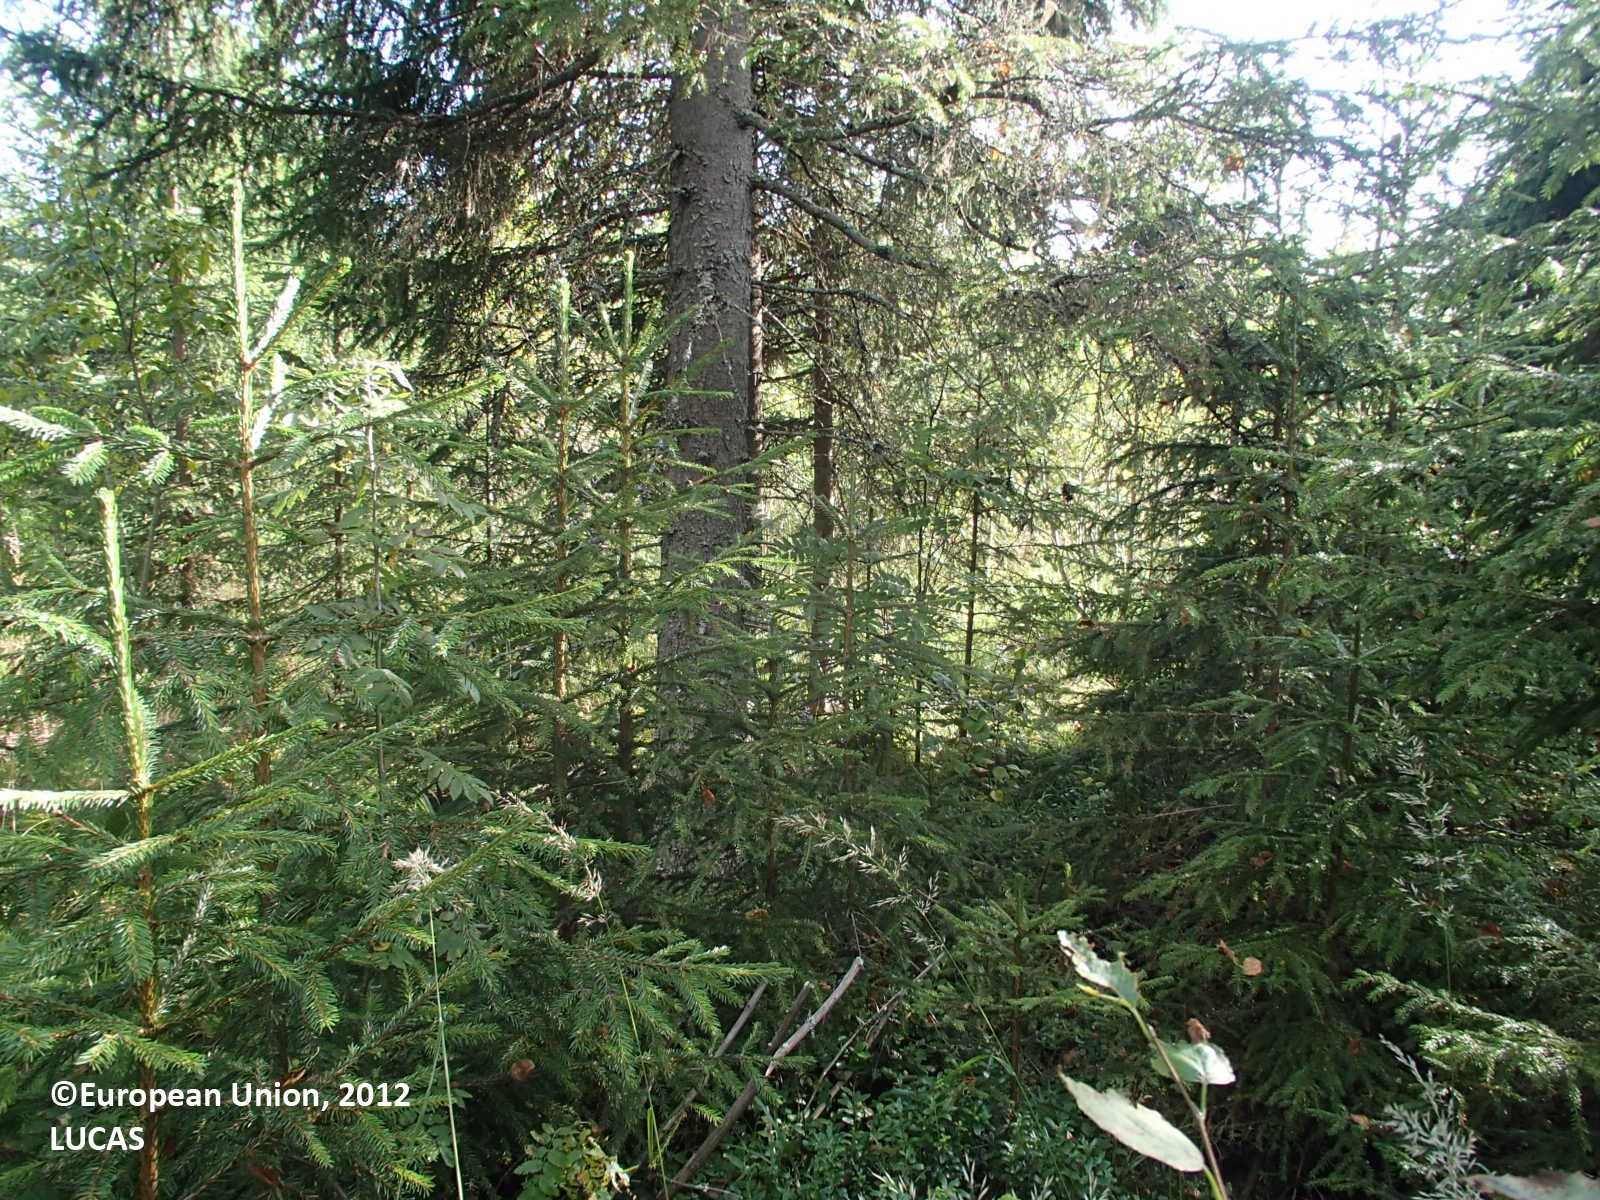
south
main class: Woodland
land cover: Spruce dominated mixed woodland
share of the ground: > 75 %
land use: Forestry
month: August
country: FI
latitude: 63.4571
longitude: 27.9210
